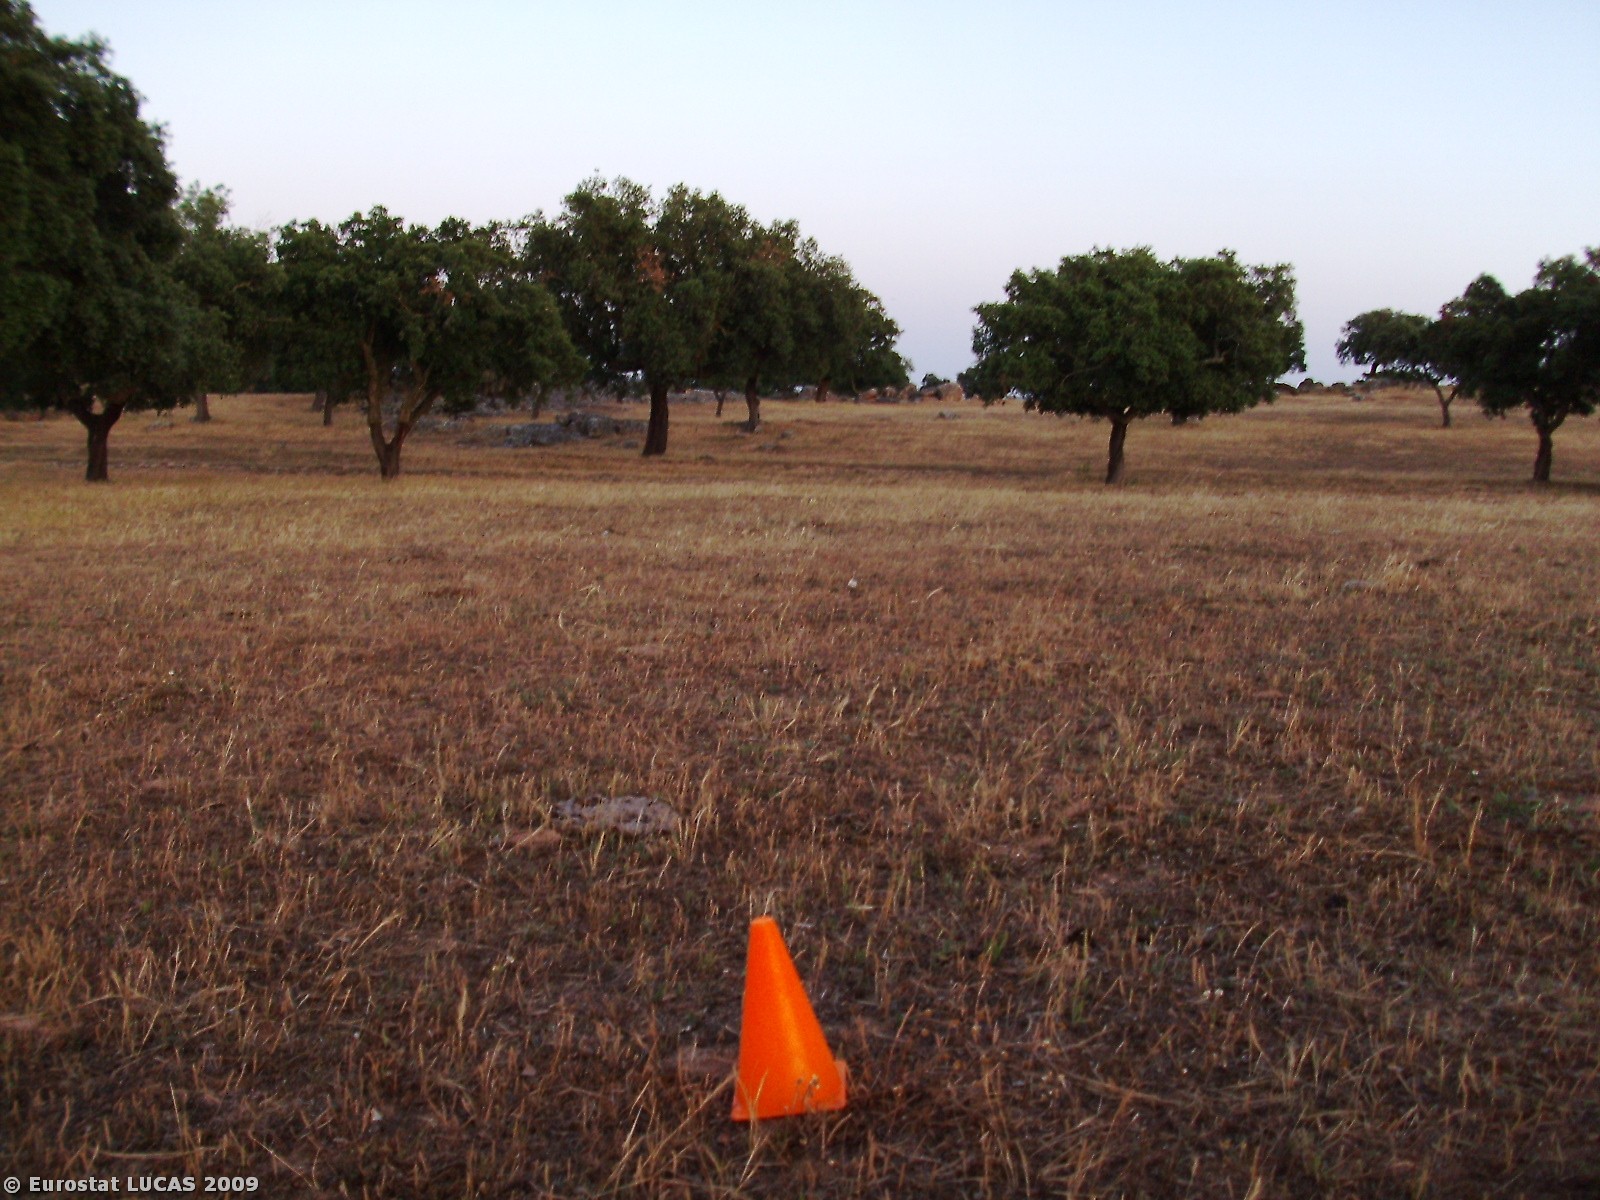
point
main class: Grassland
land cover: Grassland with sparse tree/shrub cover
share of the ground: > 75 %
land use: Agriculture (excluding fallow land and kitchen gardens)
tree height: > 5 m
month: May
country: PT
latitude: 38.9518
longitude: -7.3297
